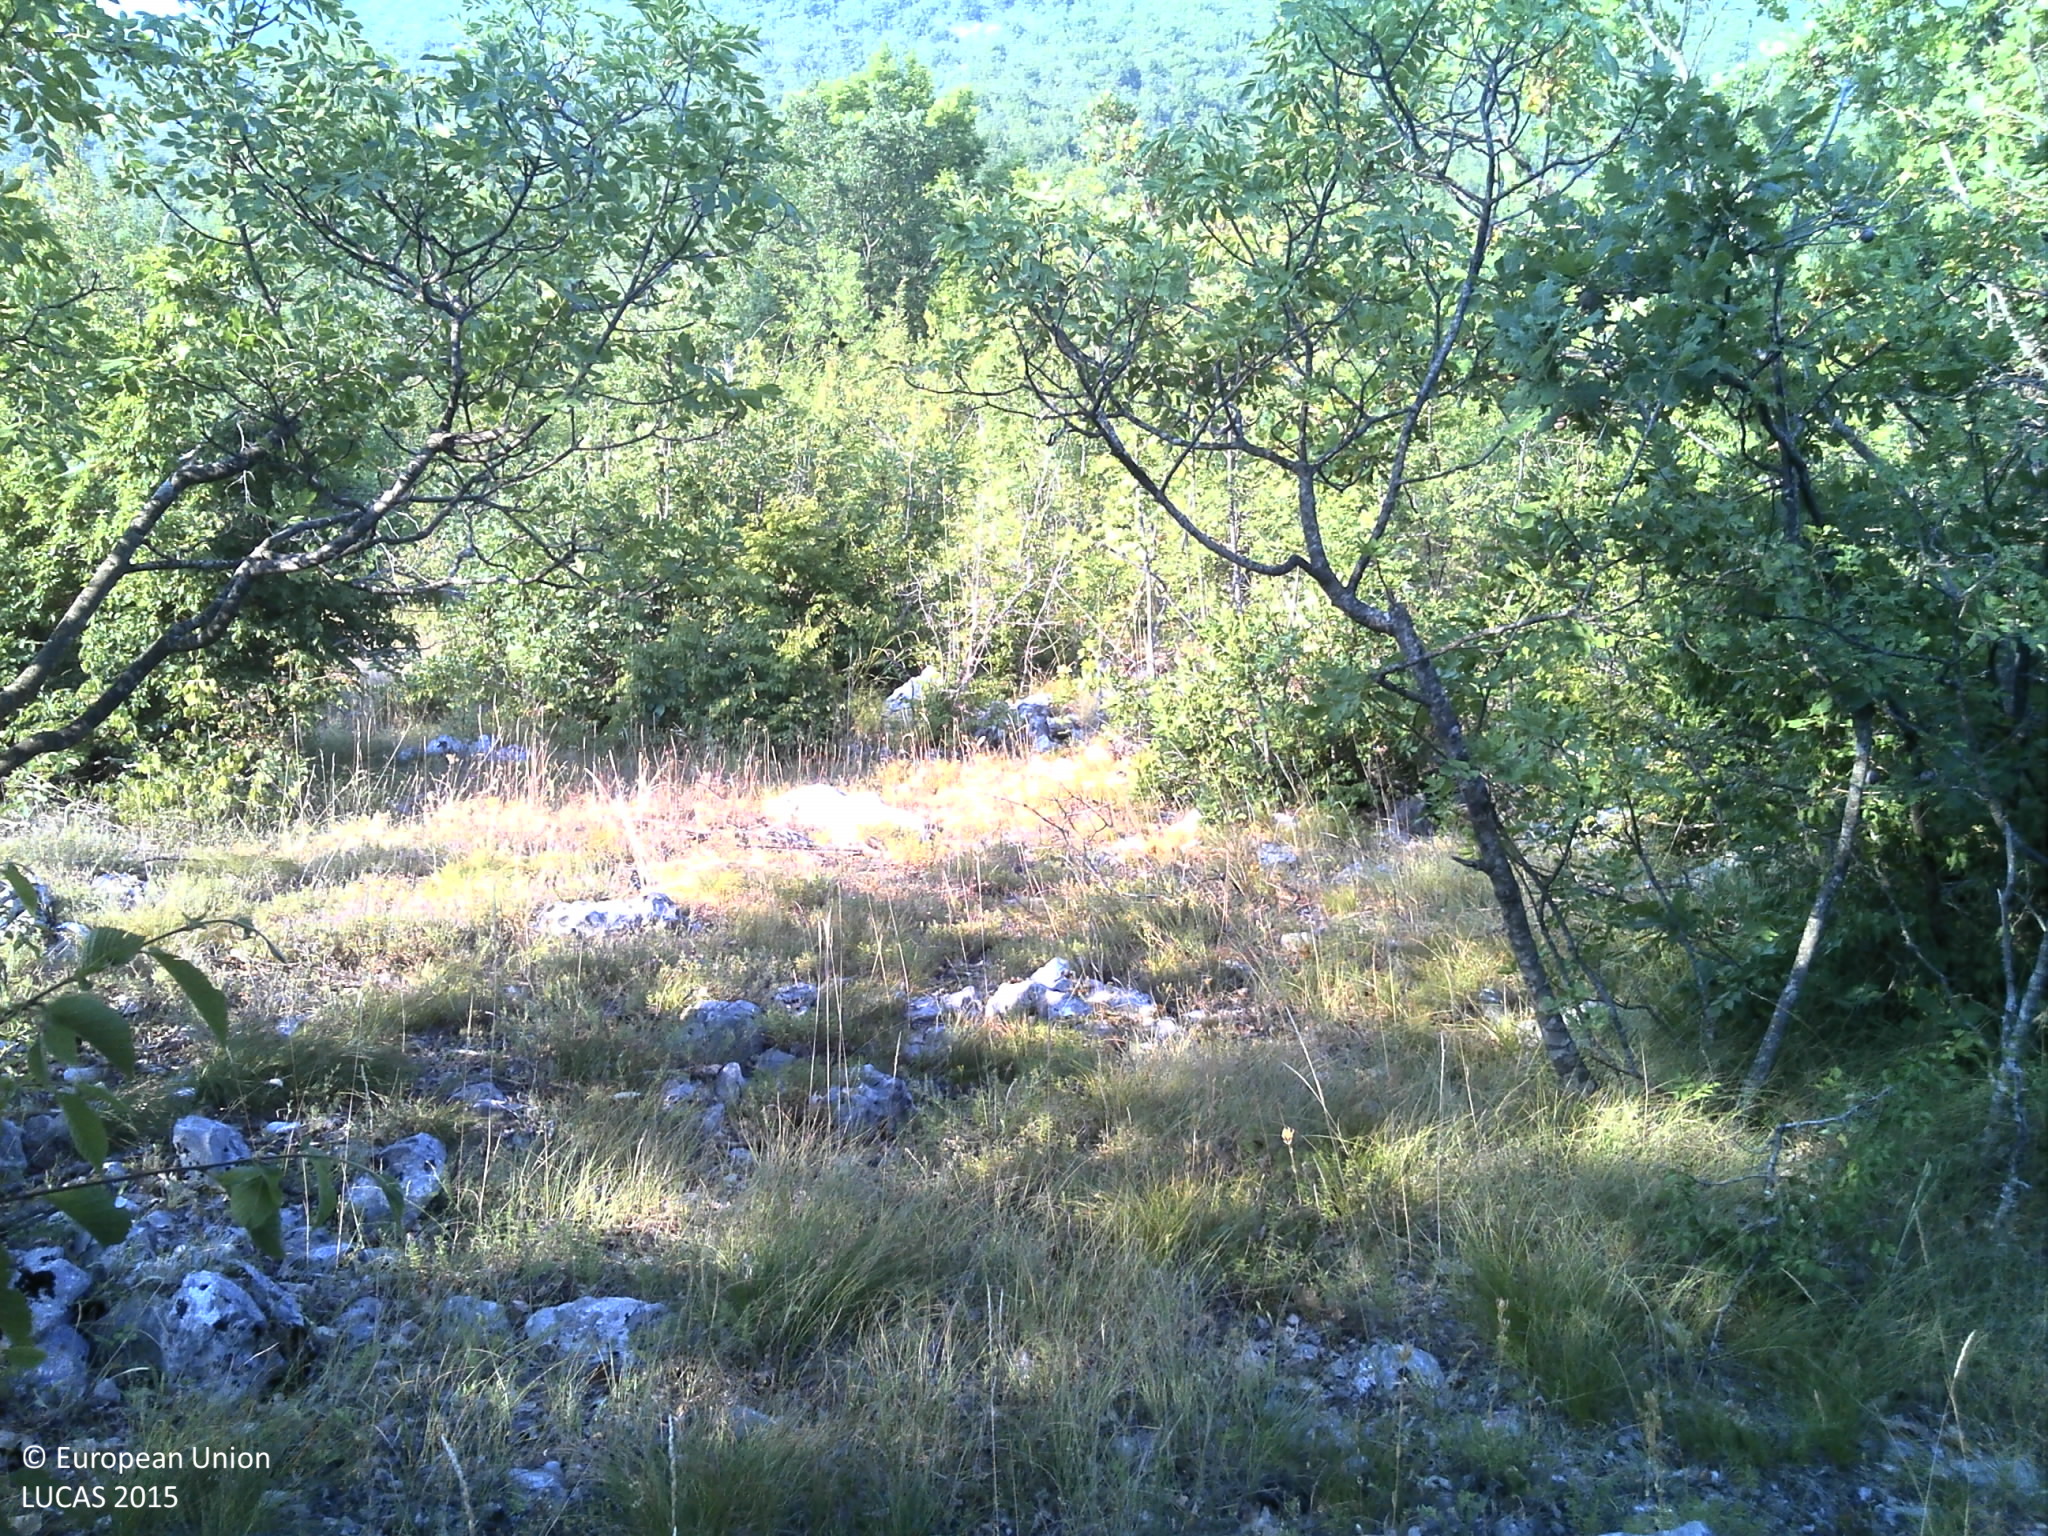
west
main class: Woodland
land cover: Broadleaved woodland
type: thermophilous deciduous forest
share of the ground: 50 - 75 %
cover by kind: broadleaved forest trees 60 %, herbaceous plants 20 %, shrubs 15 %, consolidated bare surface 5 %
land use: Semi-natural and natural areas not in use
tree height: > 5 m
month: July
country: HR
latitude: 43.3658
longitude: 17.0869
